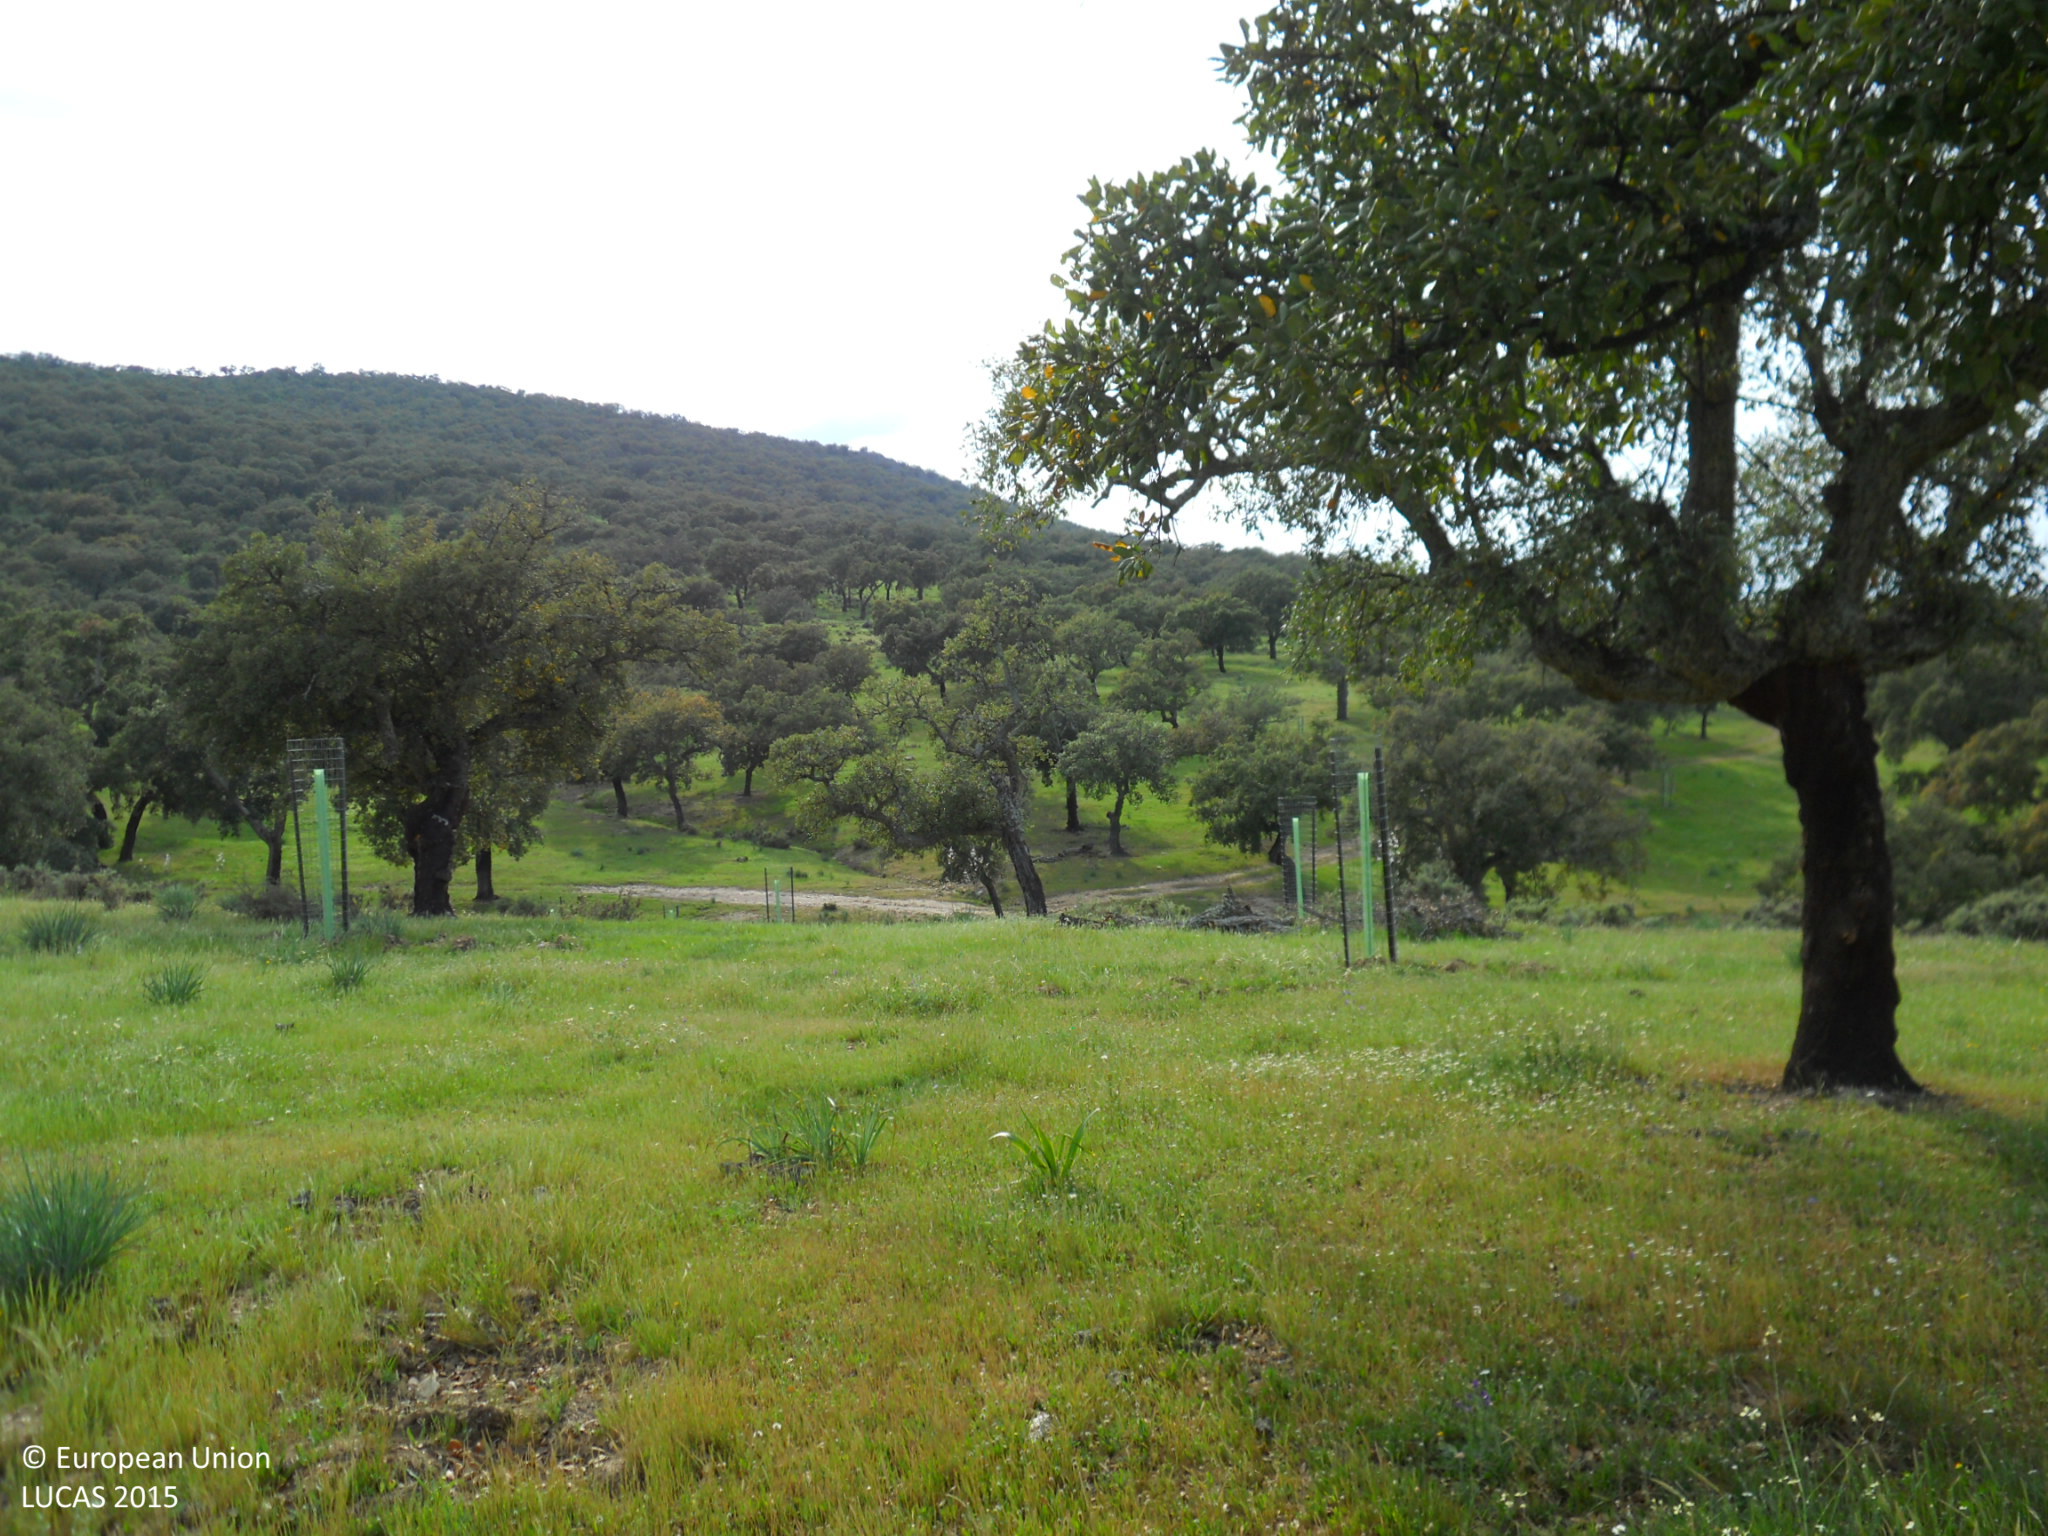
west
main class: Woodland
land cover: Broadleaved woodland
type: broadleaved evergreen forest
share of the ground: 10 - 25 %
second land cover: Grassland without tree/shrub cover
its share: > 75 %
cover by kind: herbaceous plants 80 %, broadleaved forest trees 20 %
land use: Forestry
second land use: Agriculture (excluding fallow land and kitchen gardens)
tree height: > 5 m
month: April
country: ES
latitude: 39.1979
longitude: -6.5672
